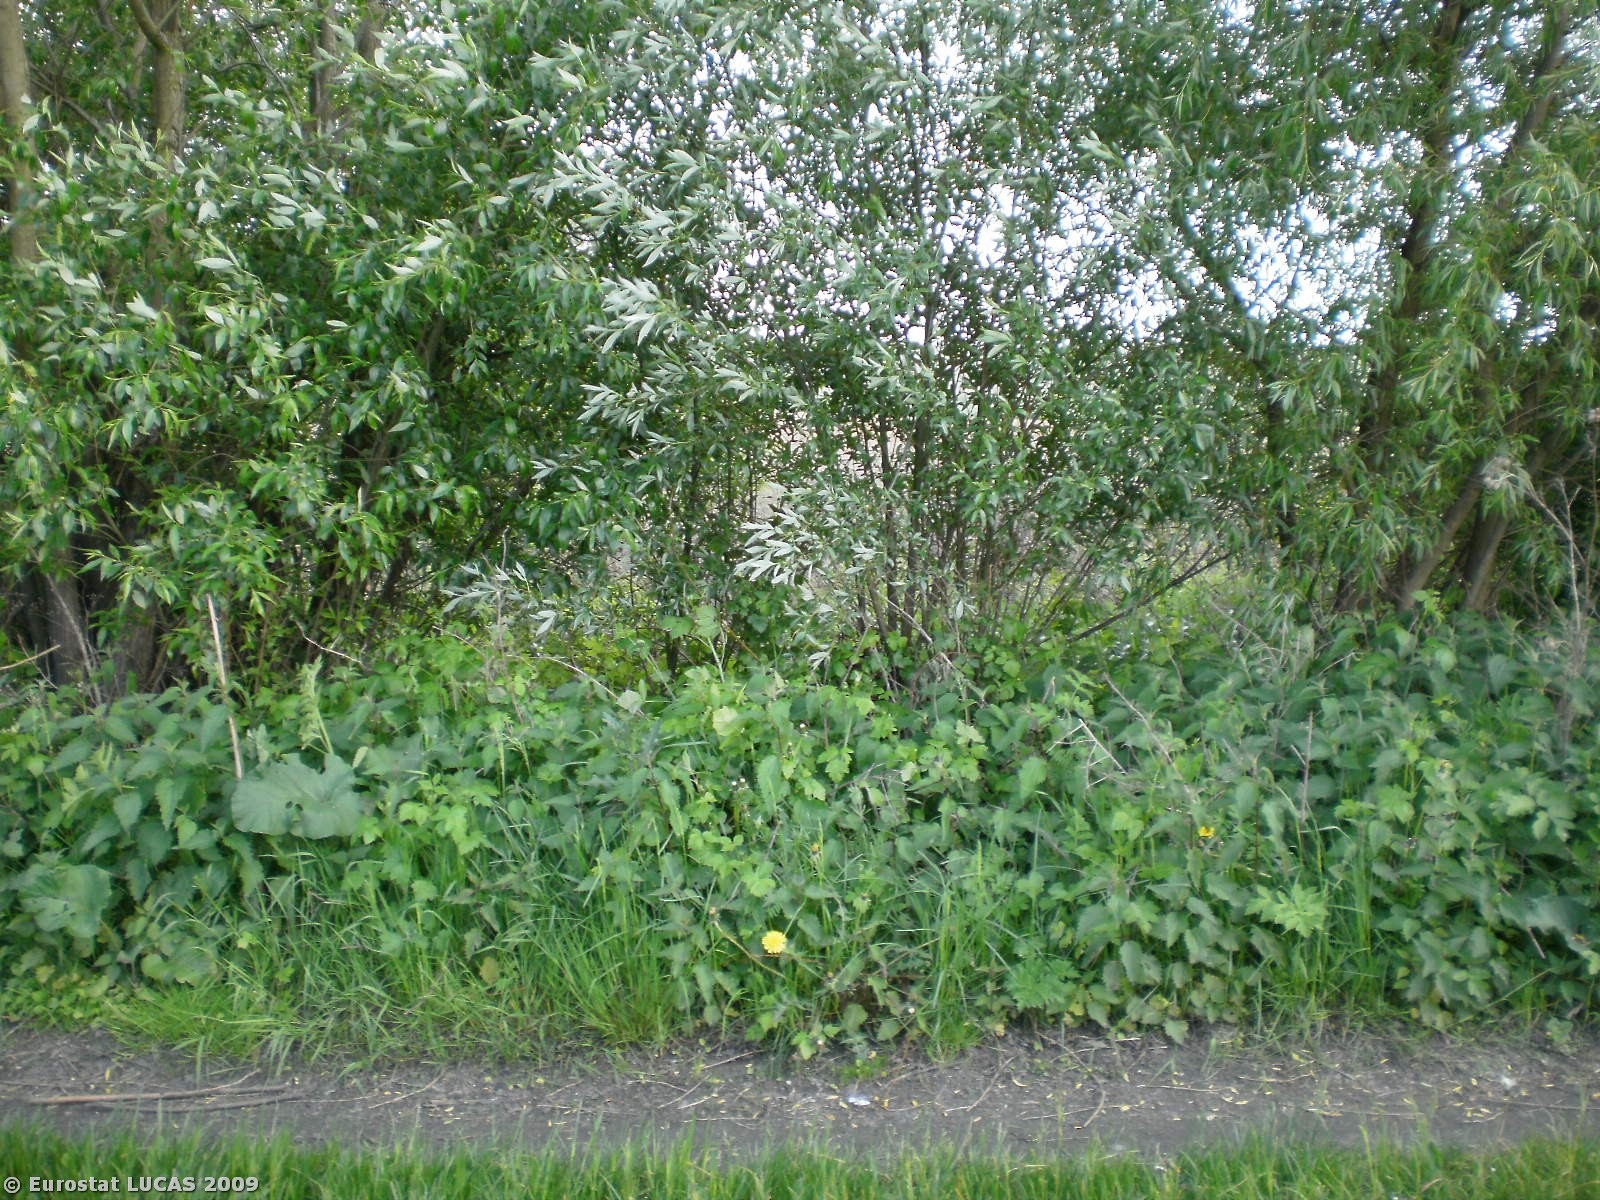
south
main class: Cropland
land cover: Rape and turnip rape
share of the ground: > 75 %
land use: Agriculture (excluding fallow land and kitchen gardens)
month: May
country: PL
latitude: 53.3361
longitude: 17.7172
